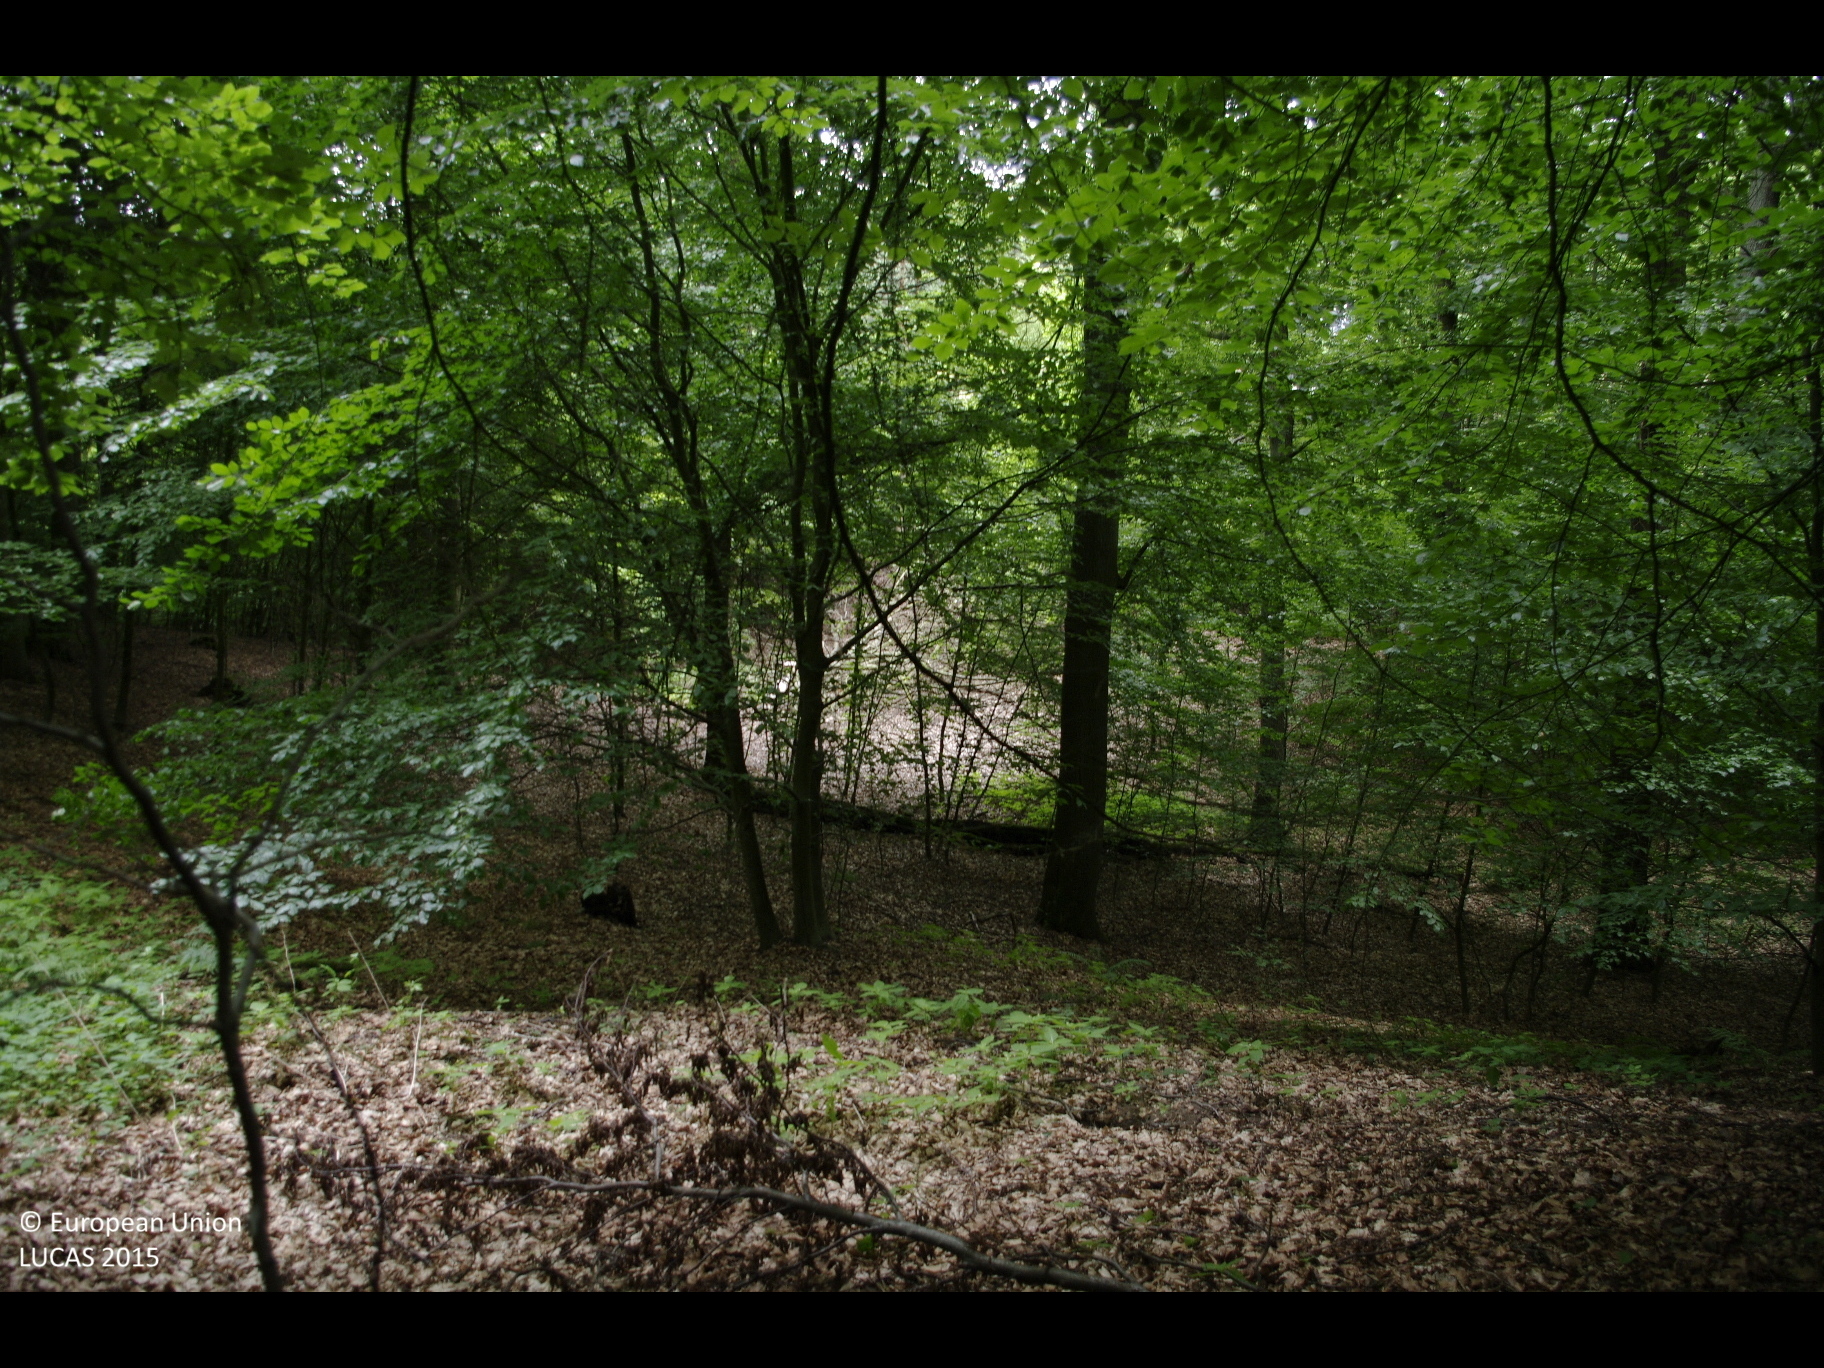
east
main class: Woodland
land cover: Broadleaved woodland
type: mesophytic deciduous forest
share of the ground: > 75 %
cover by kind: broadleaved forest trees 90 %, herbaceous plants 5 %, unconsolidated bare surface 5 %
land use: Forestry
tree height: > 5 m
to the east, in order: Broadleaved woodland; Fences; Shrubland with sparse tree cover; Paved roads, cycling and walking lanes; Grassland without tree/shrub cover; Broadleaved woodland; Spruce dominated mixed woodland; Pine dominated mixed woodland
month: July
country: DE
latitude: 53.4558
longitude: 9.9247
